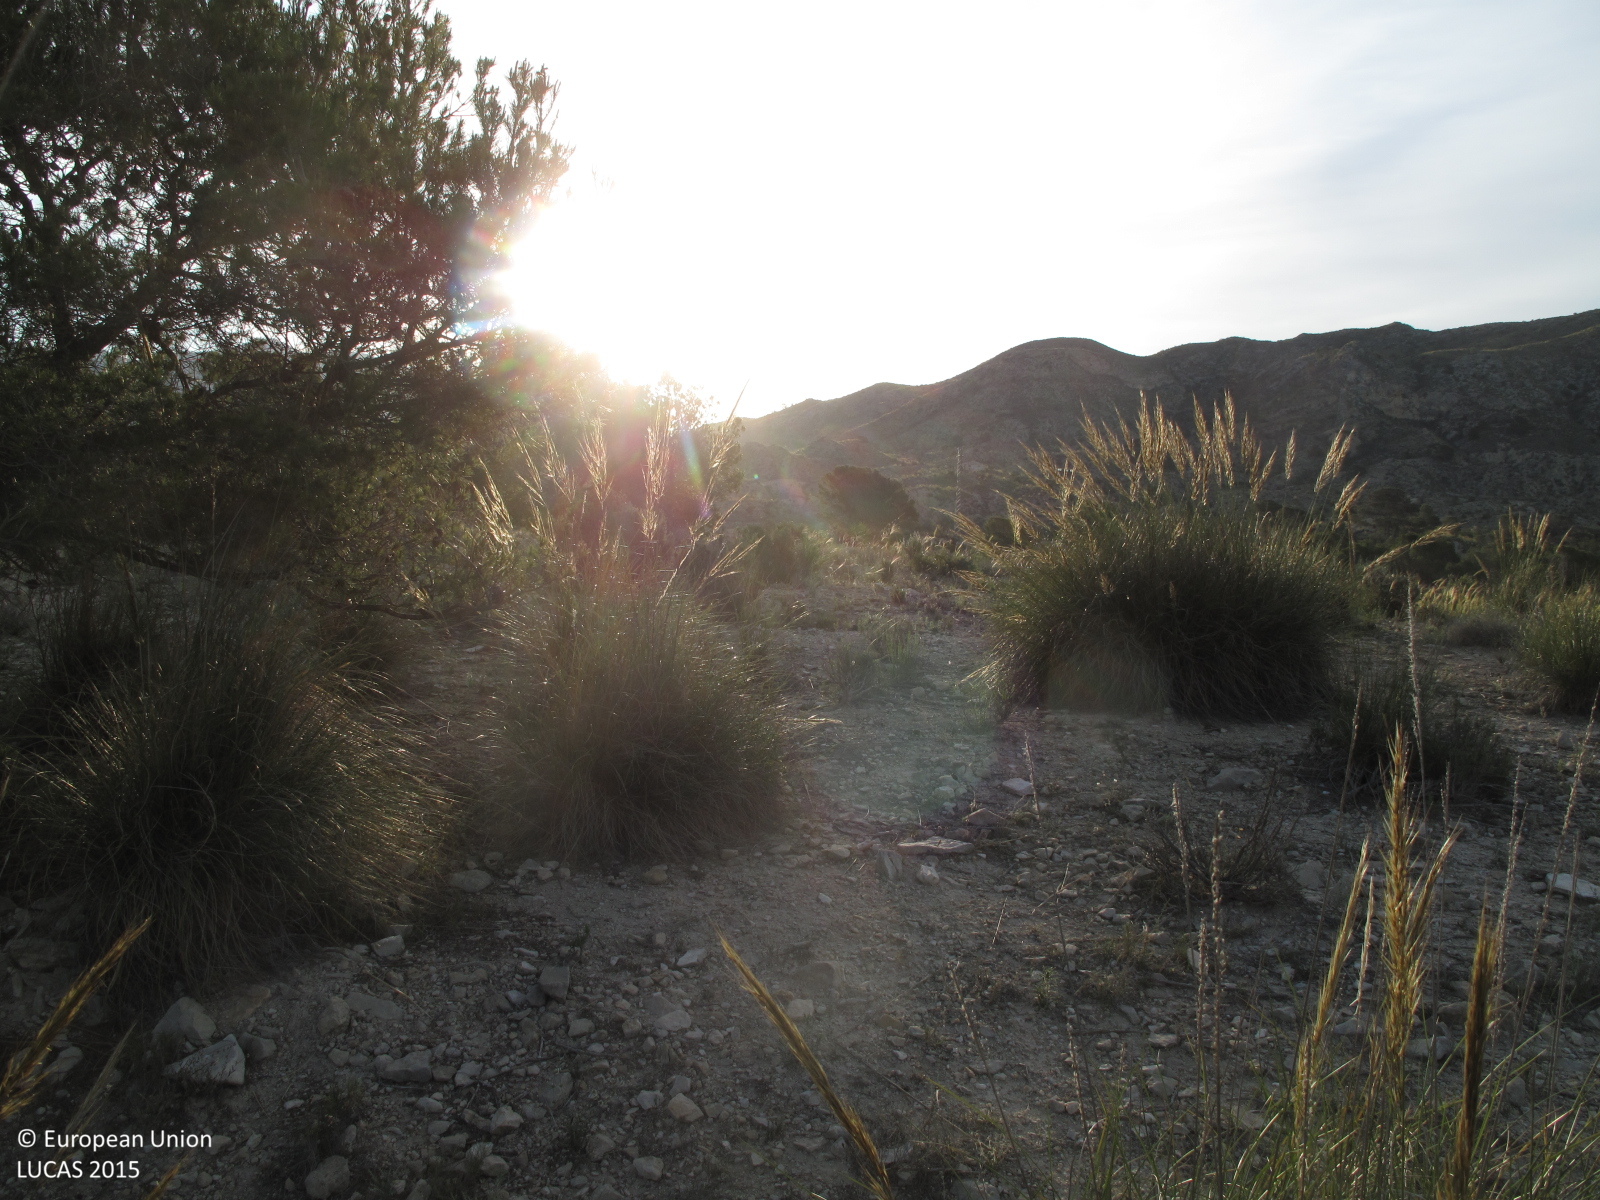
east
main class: Shrubland
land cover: Shrubland with sparse tree cover
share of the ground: 10 - 25 %
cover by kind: consolidated bare surface 75 %, shrubs 10 %, herbaceous plants 10 %, coniferous forest trees 5 %
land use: Semi-natural and natural areas not in use
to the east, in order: Shrubland with sparse tree cover; Electric lines; Shrubland with sparse tree cover; Tracks; Shrubland without tree cover; Electric lines; Shrubland with sparse tree cover; Pine dominated coniferous woodland; Tracks; Shrubland without tree cover; Electric lines; Shrubland without tree cover
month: April
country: ES
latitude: 38.5005
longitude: -0.4790
